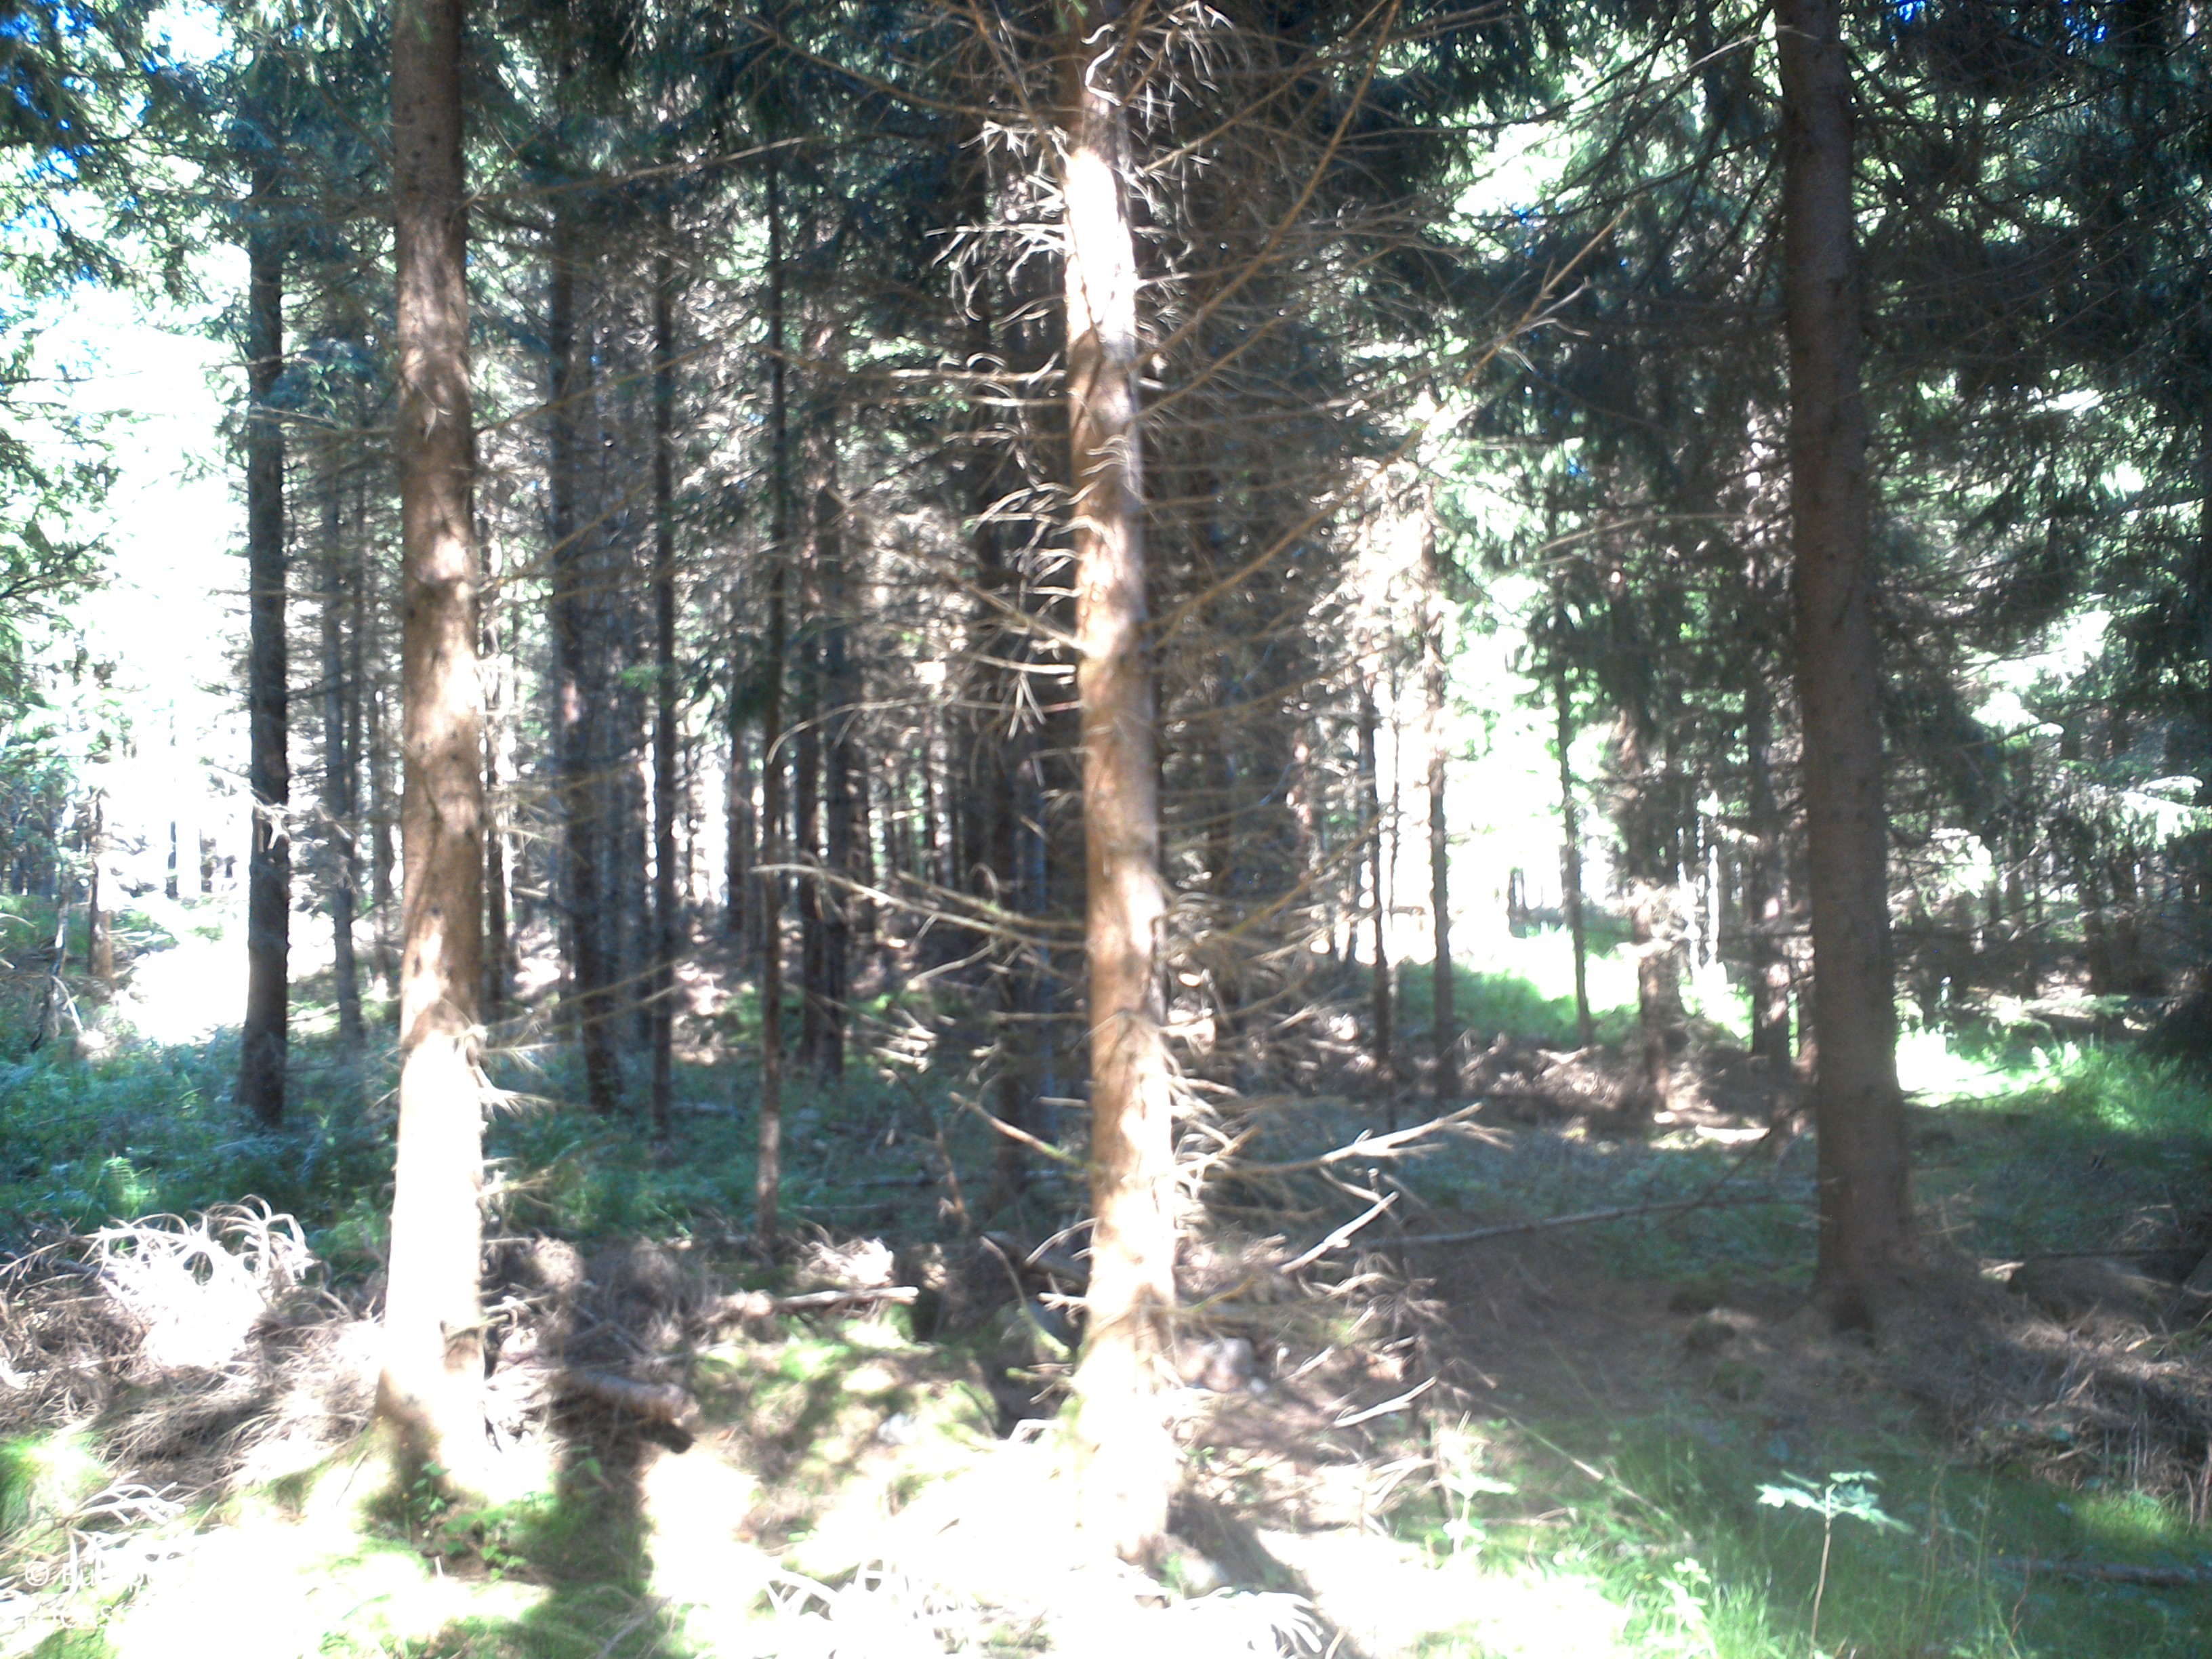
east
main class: Woodland
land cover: Spruce dominated coniferous woodland
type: boreal forest
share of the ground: > 75 %
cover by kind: coniferous forest trees 85 %, herbaceous plants 5 %, lichens and mosses 5 %, unconsolidated bare surface 5 %
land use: Forestry
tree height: > 5 m
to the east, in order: Spruce dominated coniferous woodland; Ditches and canals; Spruce dominated coniferous woodland; Ditches and canals; Dry stone walls; Spruce dominated coniferous woodland; Grass margins; Paved roads, cycling and walking lanes; Grass margins; Grassland with sparse tree/shrub cover; Broadleaved woodland; Dry stone walls; Broadleaved woodland
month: August
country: SE
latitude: 57.8915
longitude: 15.4780
